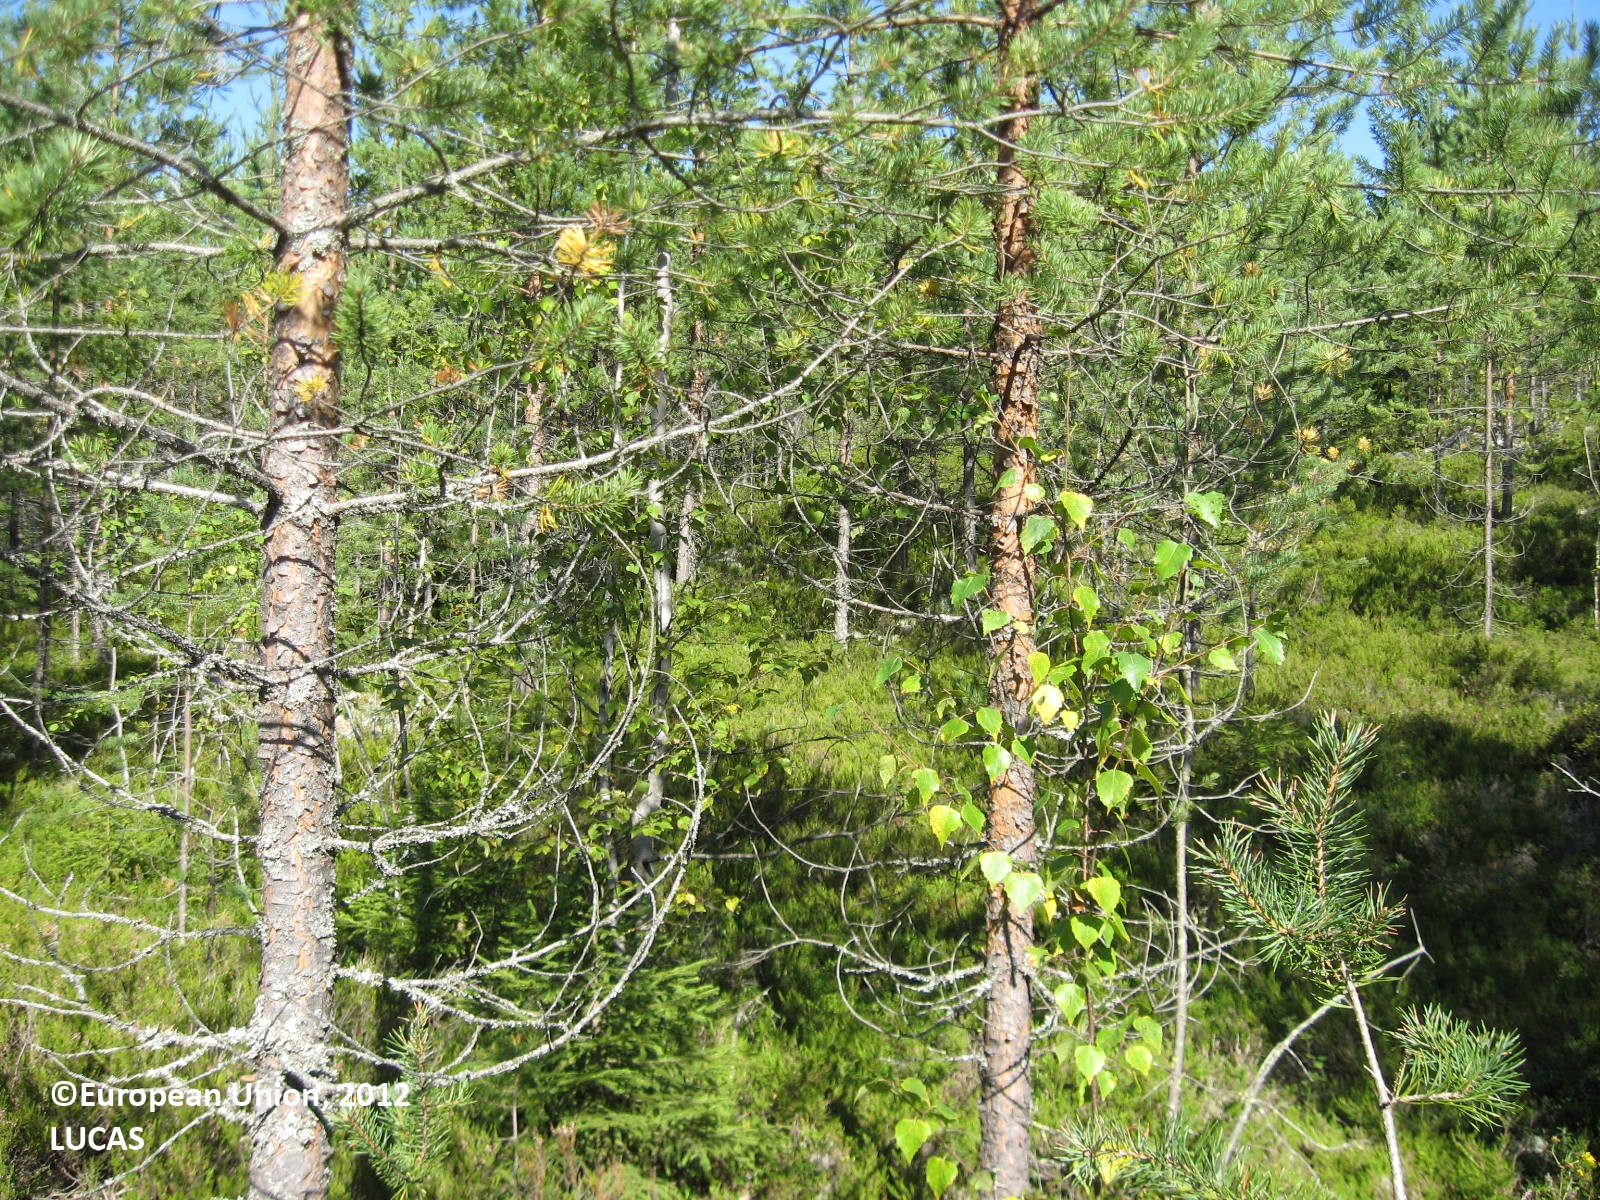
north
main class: Woodland
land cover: Pine dominated coniferous woodland
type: boreal forest
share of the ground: > 75 %
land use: Forestry
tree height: > 5 m
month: August
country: FI
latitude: 63.6475
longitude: 29.8458
